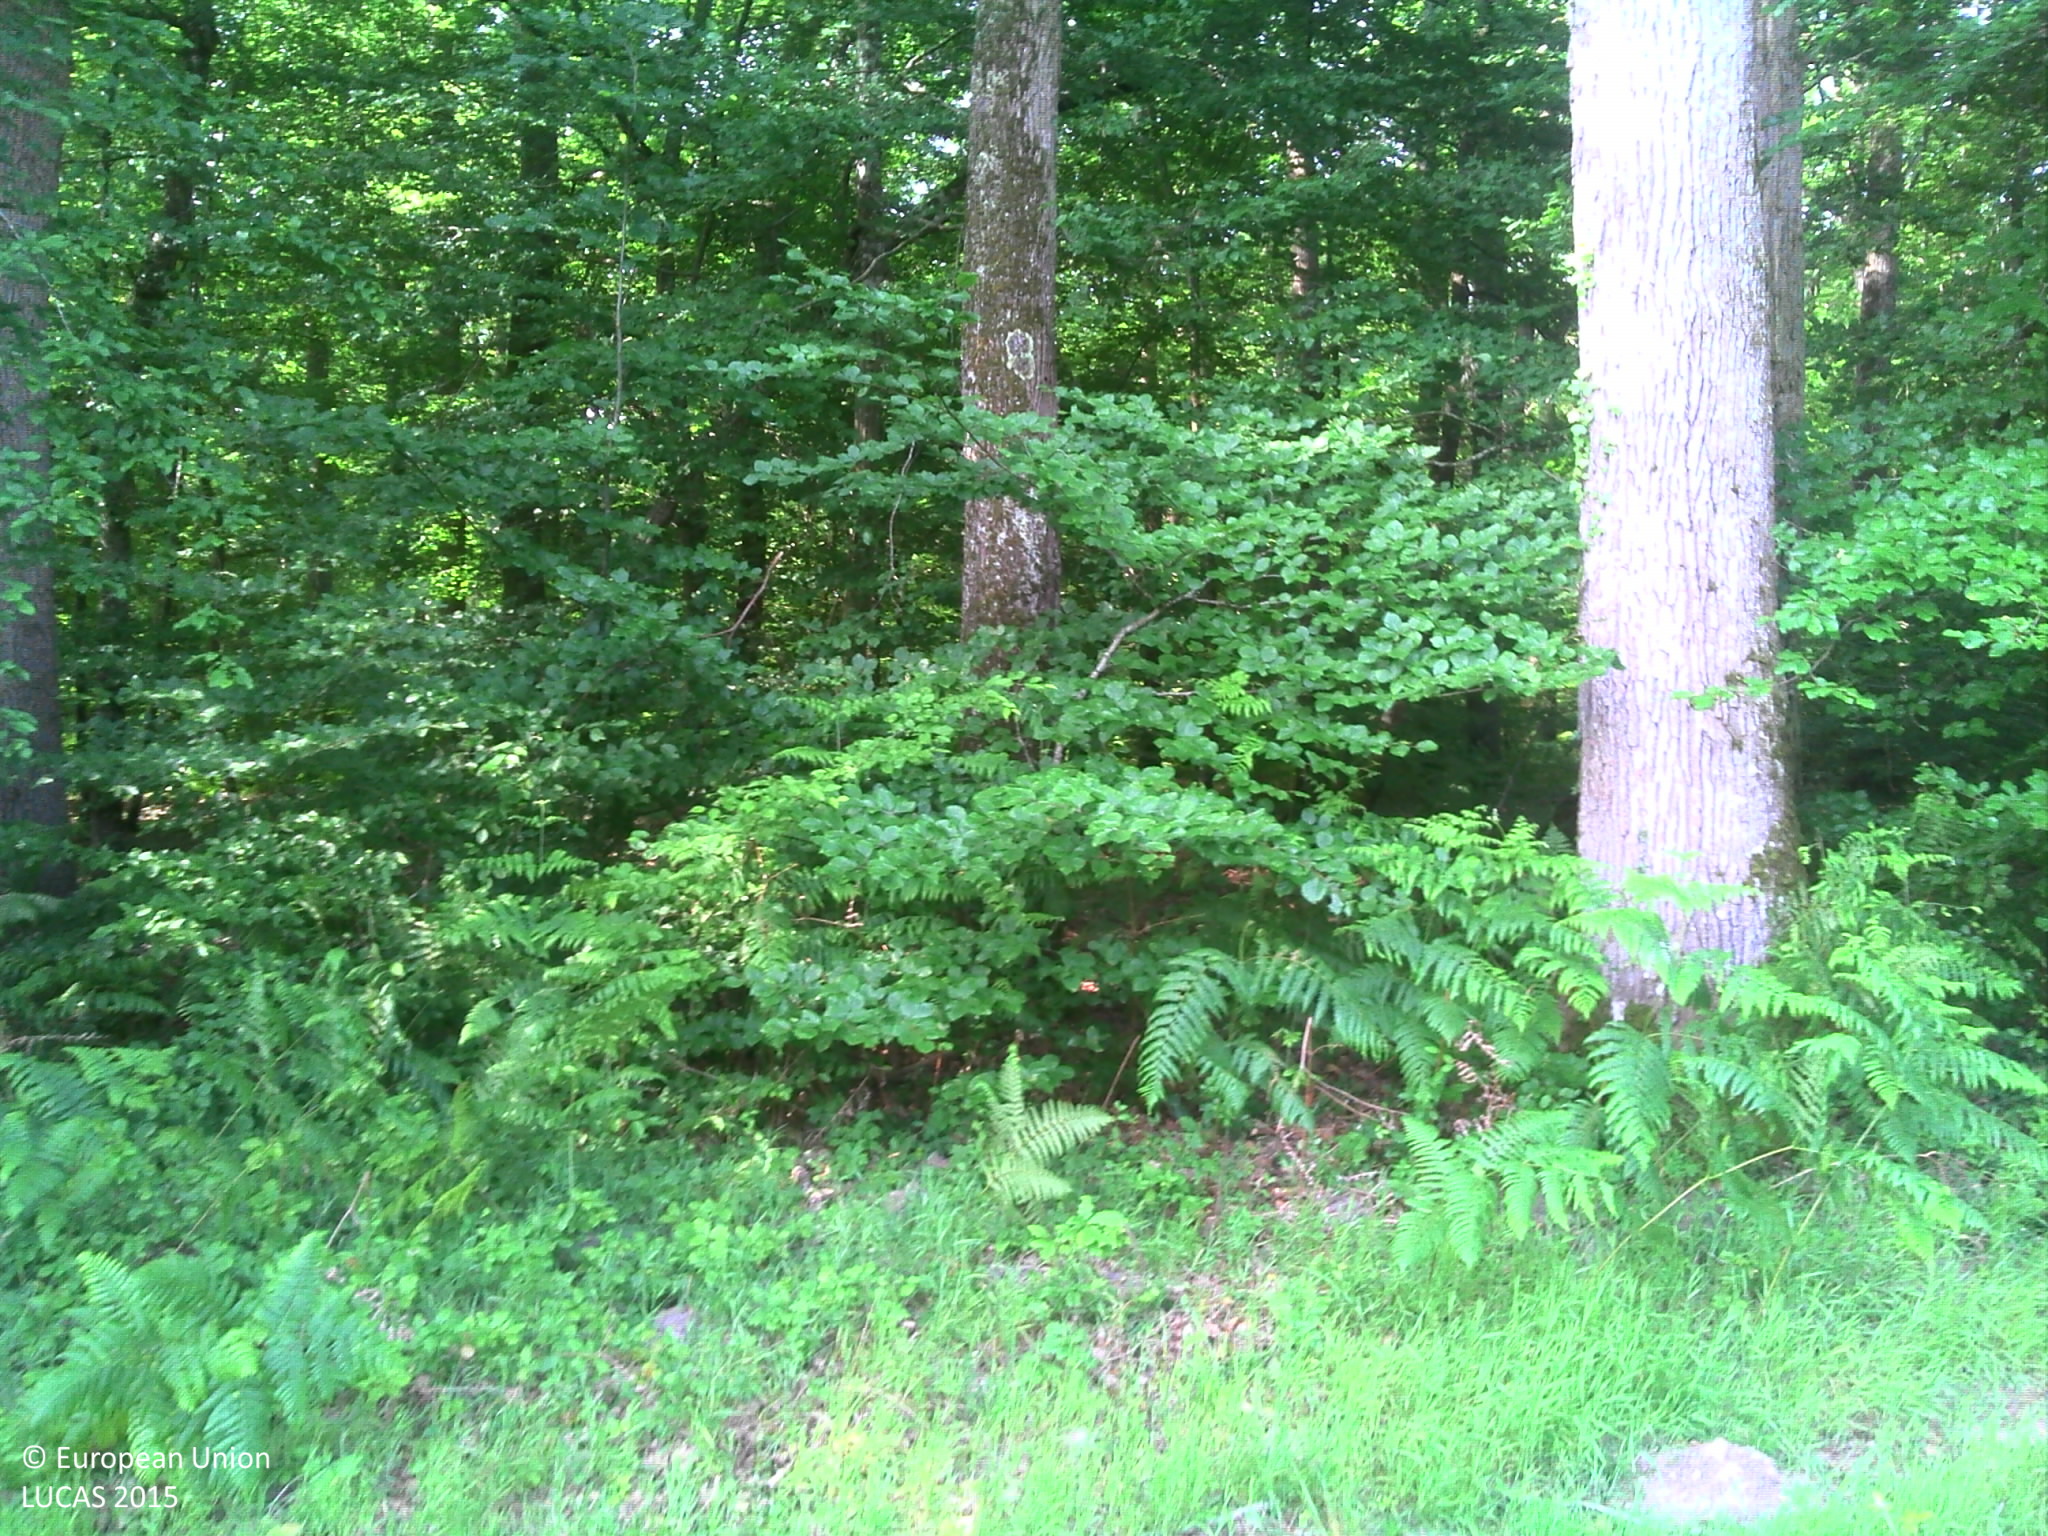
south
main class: Woodland
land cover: Broadleaved woodland
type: mesophytic deciduous forest
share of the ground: > 75 %
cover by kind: herbaceous plants 70 %, broadleaved forest trees 30 %
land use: Forestry
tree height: > 5 m
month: June
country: FR
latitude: 47.5560
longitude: 1.3335
